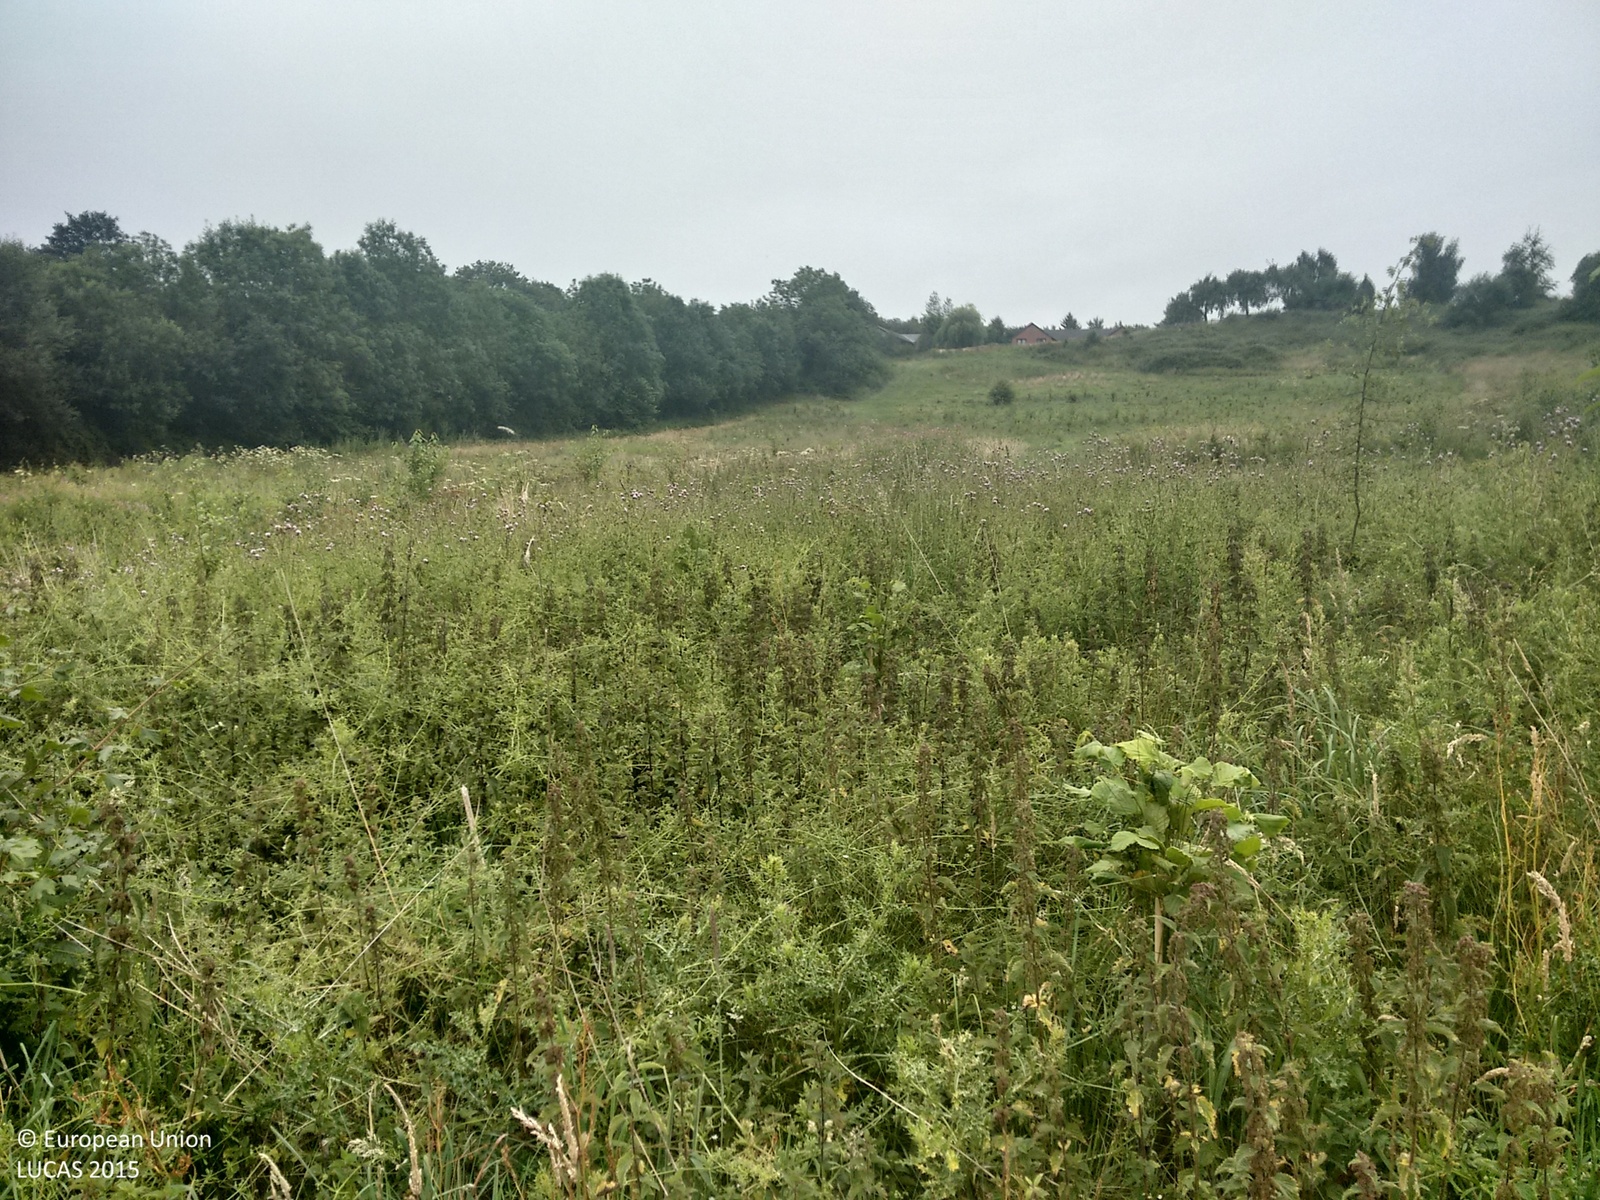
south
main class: Grassland
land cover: Grassland with sparse tree/shrub cover
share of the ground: > 75 %
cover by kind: herbaceous plants 90 %, broadleaved forest trees 5 %, shrubs 5 %
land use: Semi-natural and natural areas not in use
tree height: < 5 m
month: July
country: GB
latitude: 52.0192
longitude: -2.7039
